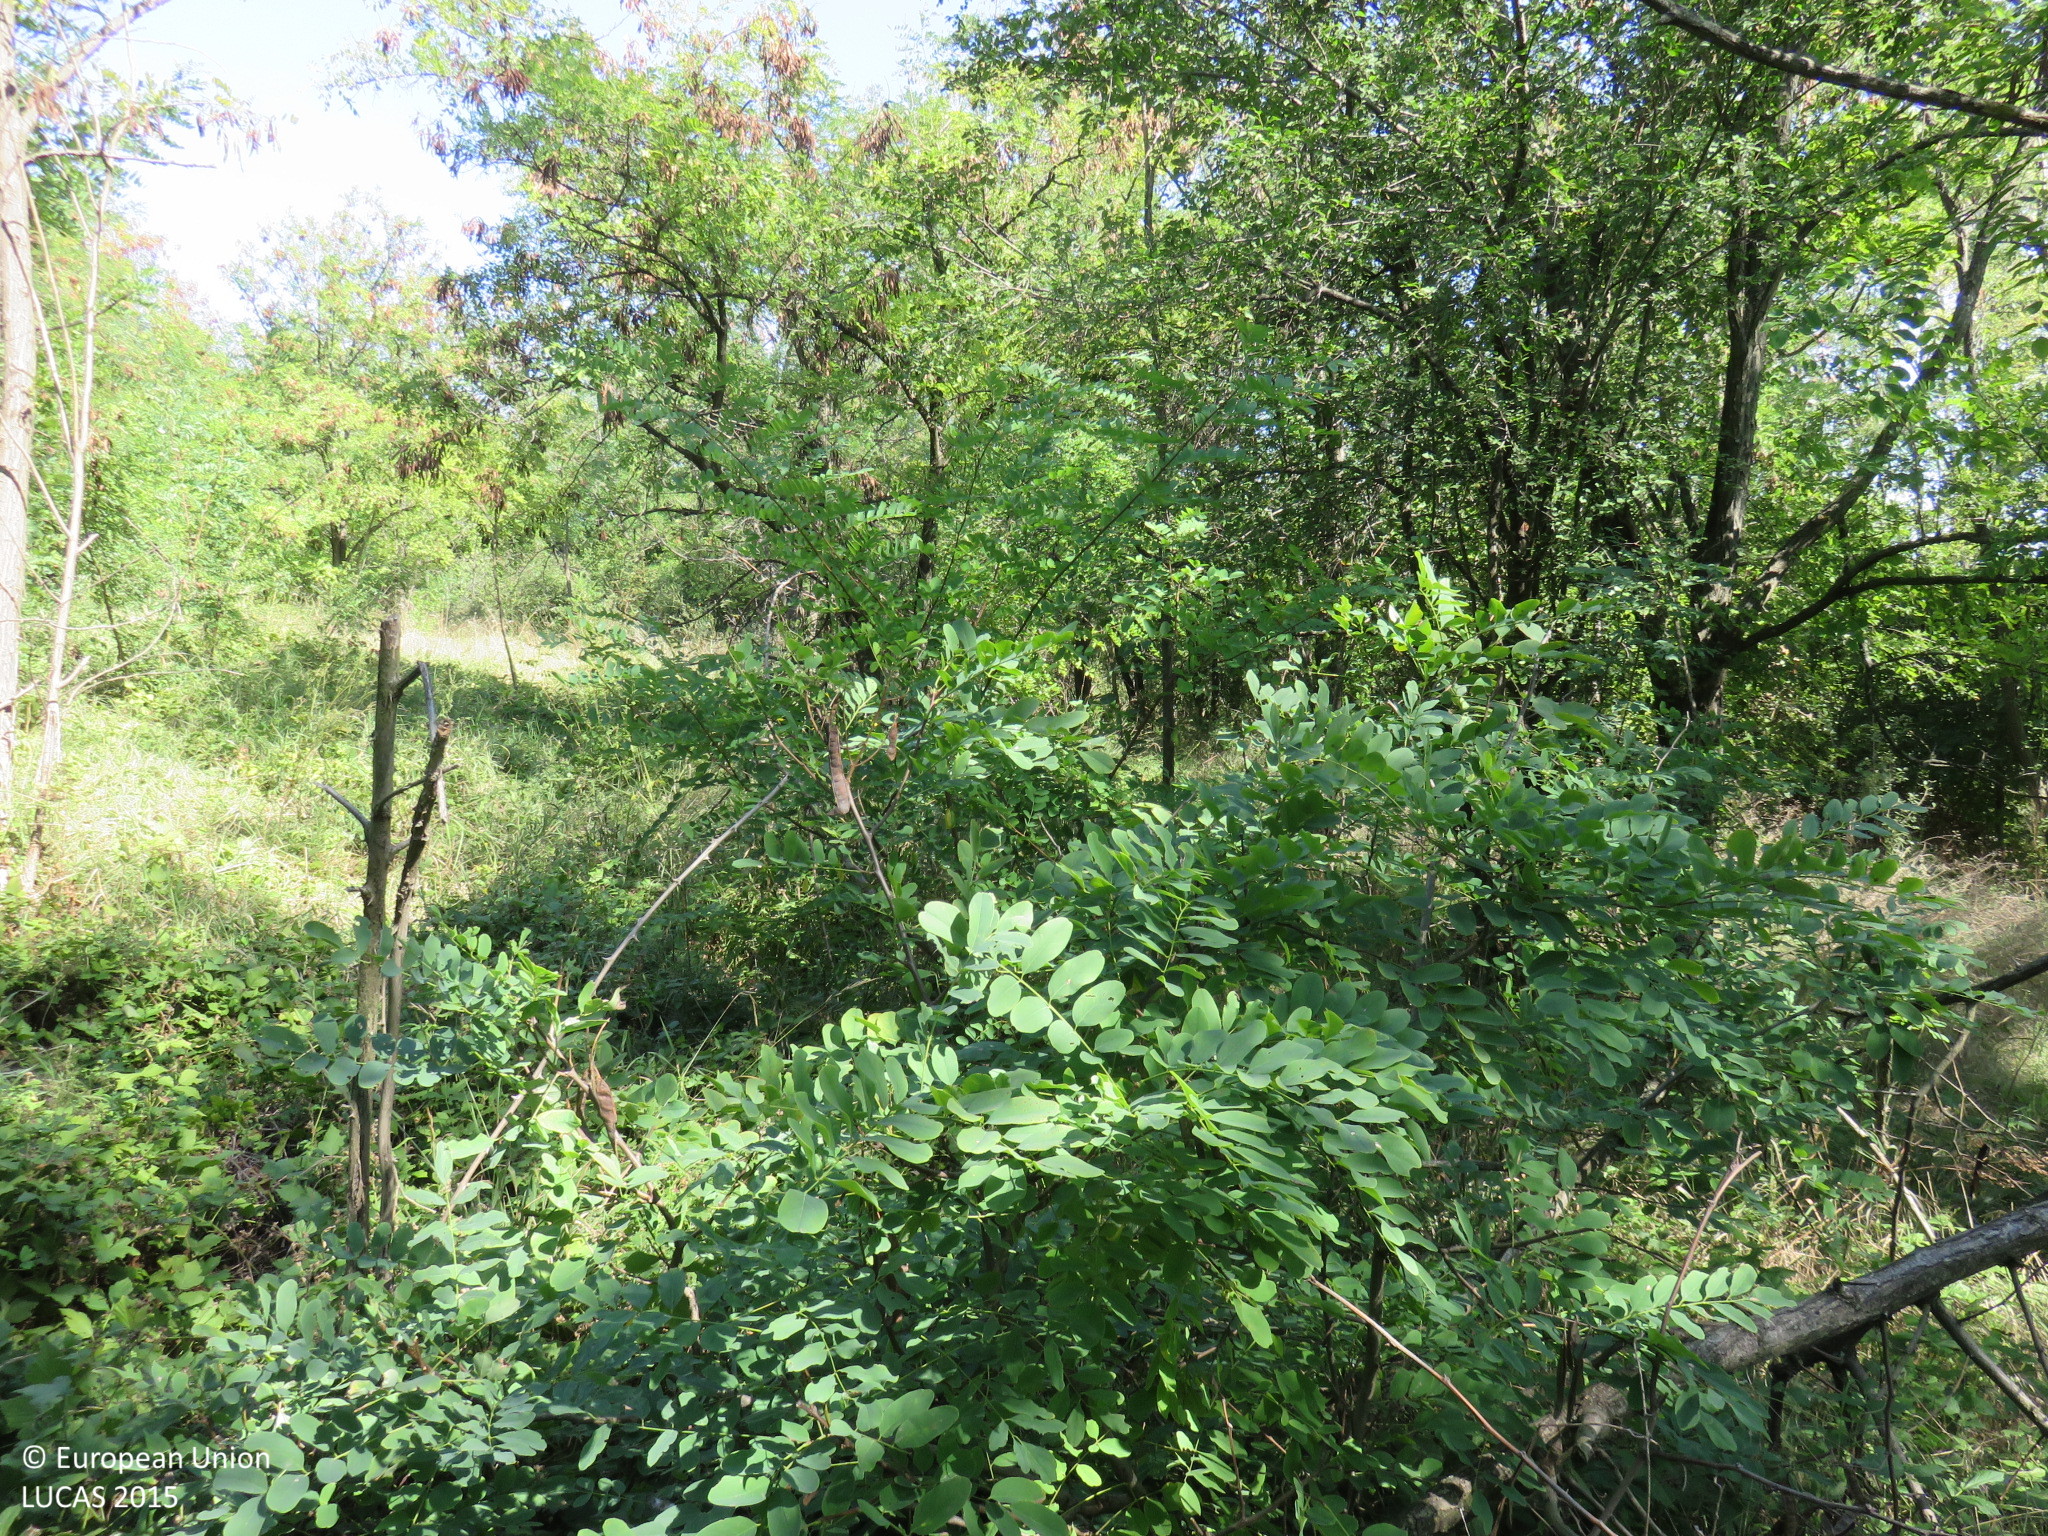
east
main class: Woodland
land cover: Broadleaved woodland
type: mesophytic deciduous forest
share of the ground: > 75 %
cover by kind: broadleaved forest trees 85 %, shrubs 10 %, herbaceous plants 5 %
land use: Forestry
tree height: < 5 m
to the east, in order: Broadleaved woodland; Shrubland with sparse tree cover; Grassland with sparse tree/shrub cover; Shrubland with sparse tree cover; Grassland with sparse tree/shrub cover
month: September
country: BG
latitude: 43.6399
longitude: 24.4793
